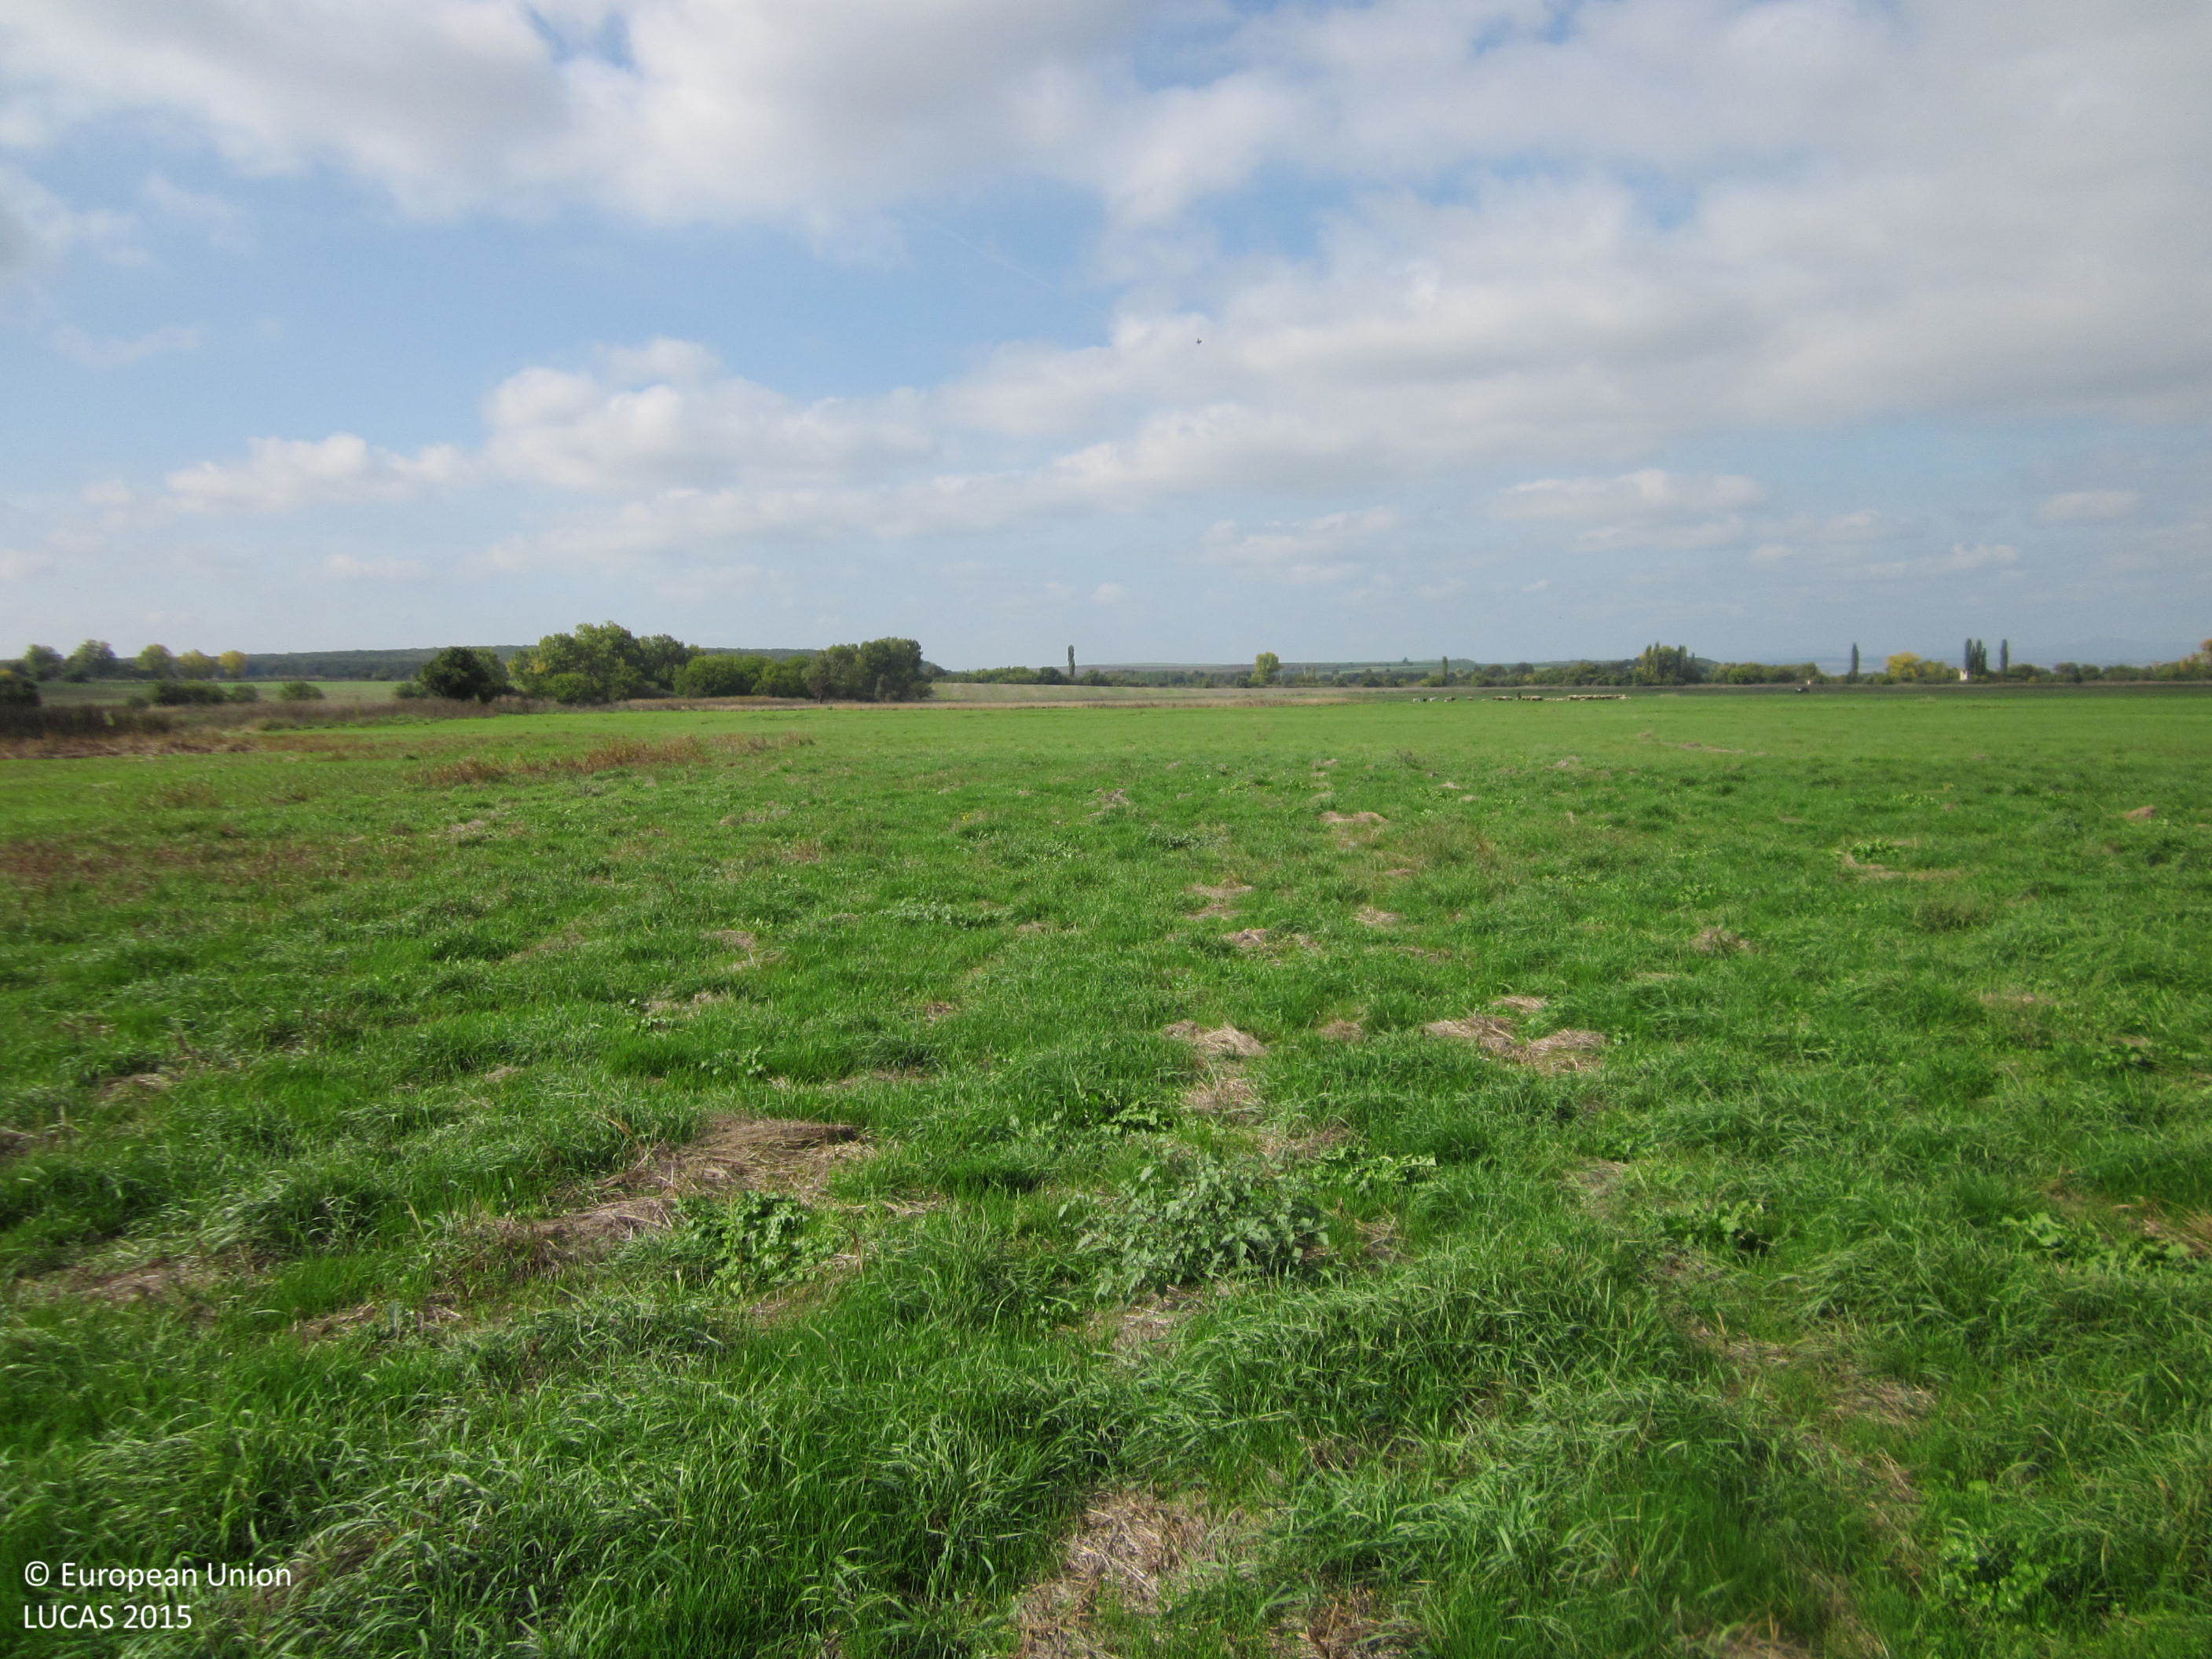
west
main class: Grassland
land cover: Grassland without tree/shrub cover
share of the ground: > 75 %
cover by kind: herbaceous plants 100 %
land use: Agriculture (excluding fallow land and kitchen gardens)
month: October
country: BG
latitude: 42.6964
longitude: 26.8888
